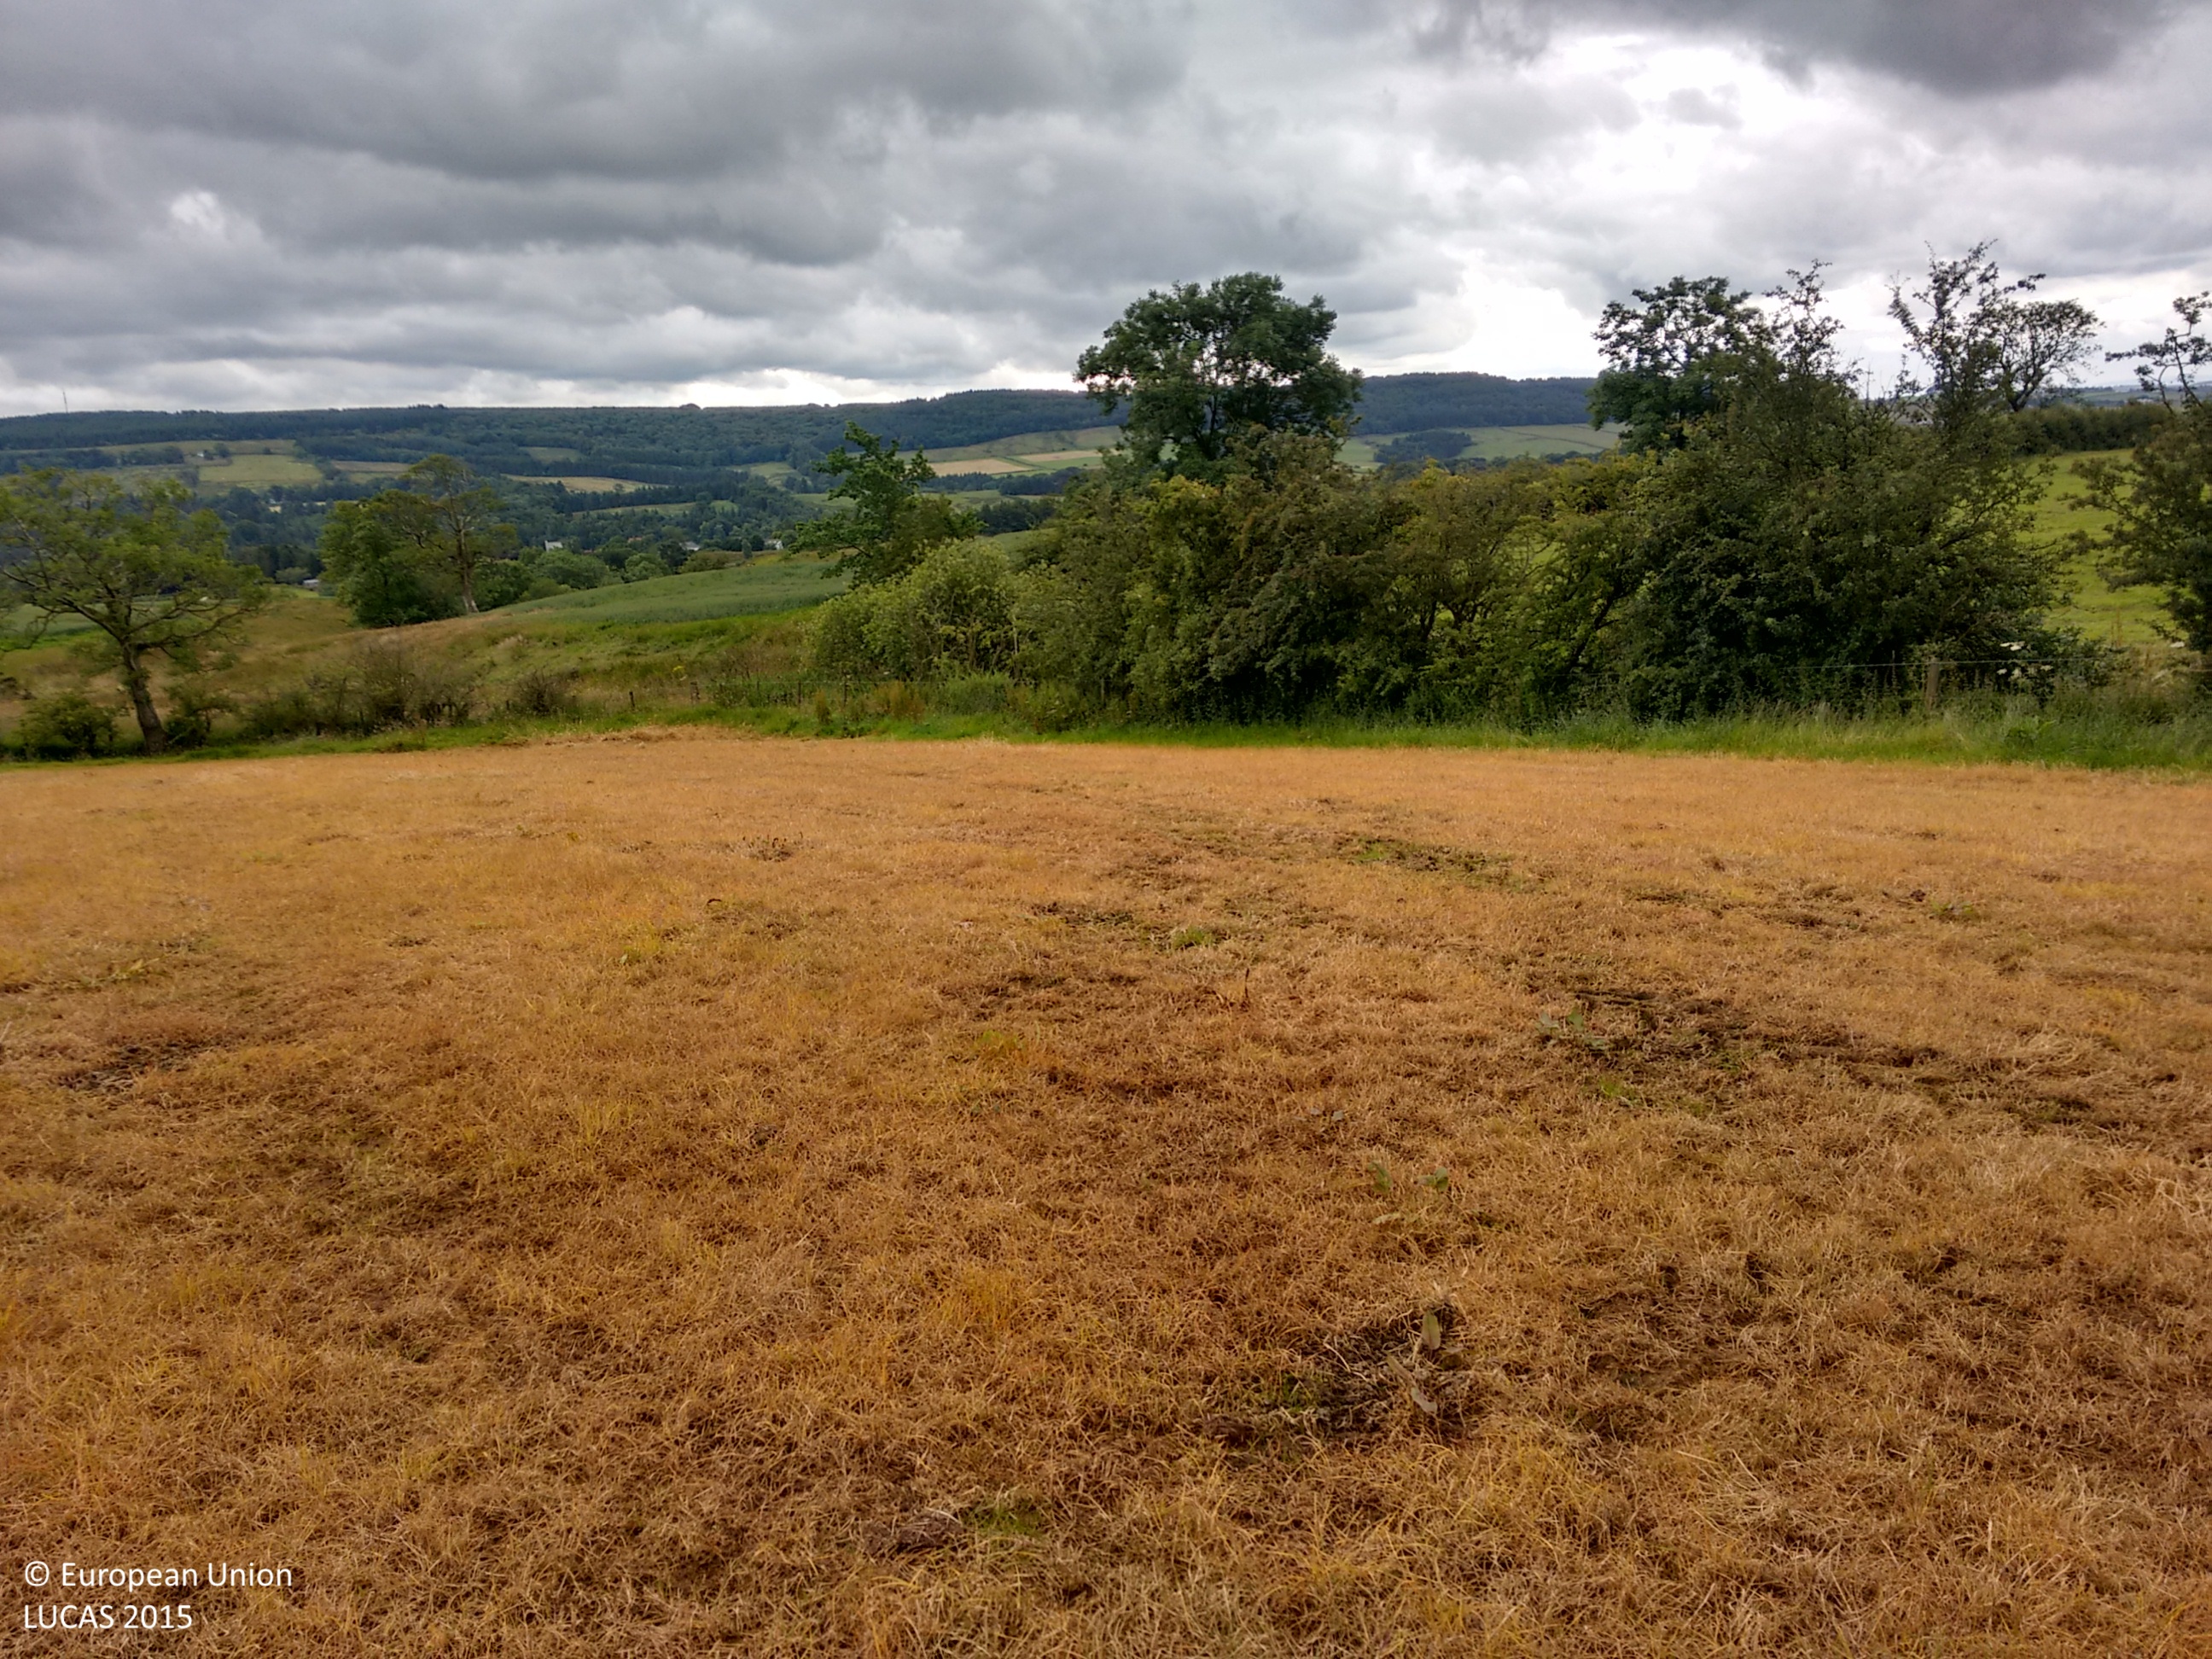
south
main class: Grassland
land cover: Grassland without tree/shrub cover
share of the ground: > 75 %
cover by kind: herbaceous plants 100 %
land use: Agriculture (excluding fallow land and kitchen gardens)
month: July
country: GB
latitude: 55.6181
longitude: -4.3064
